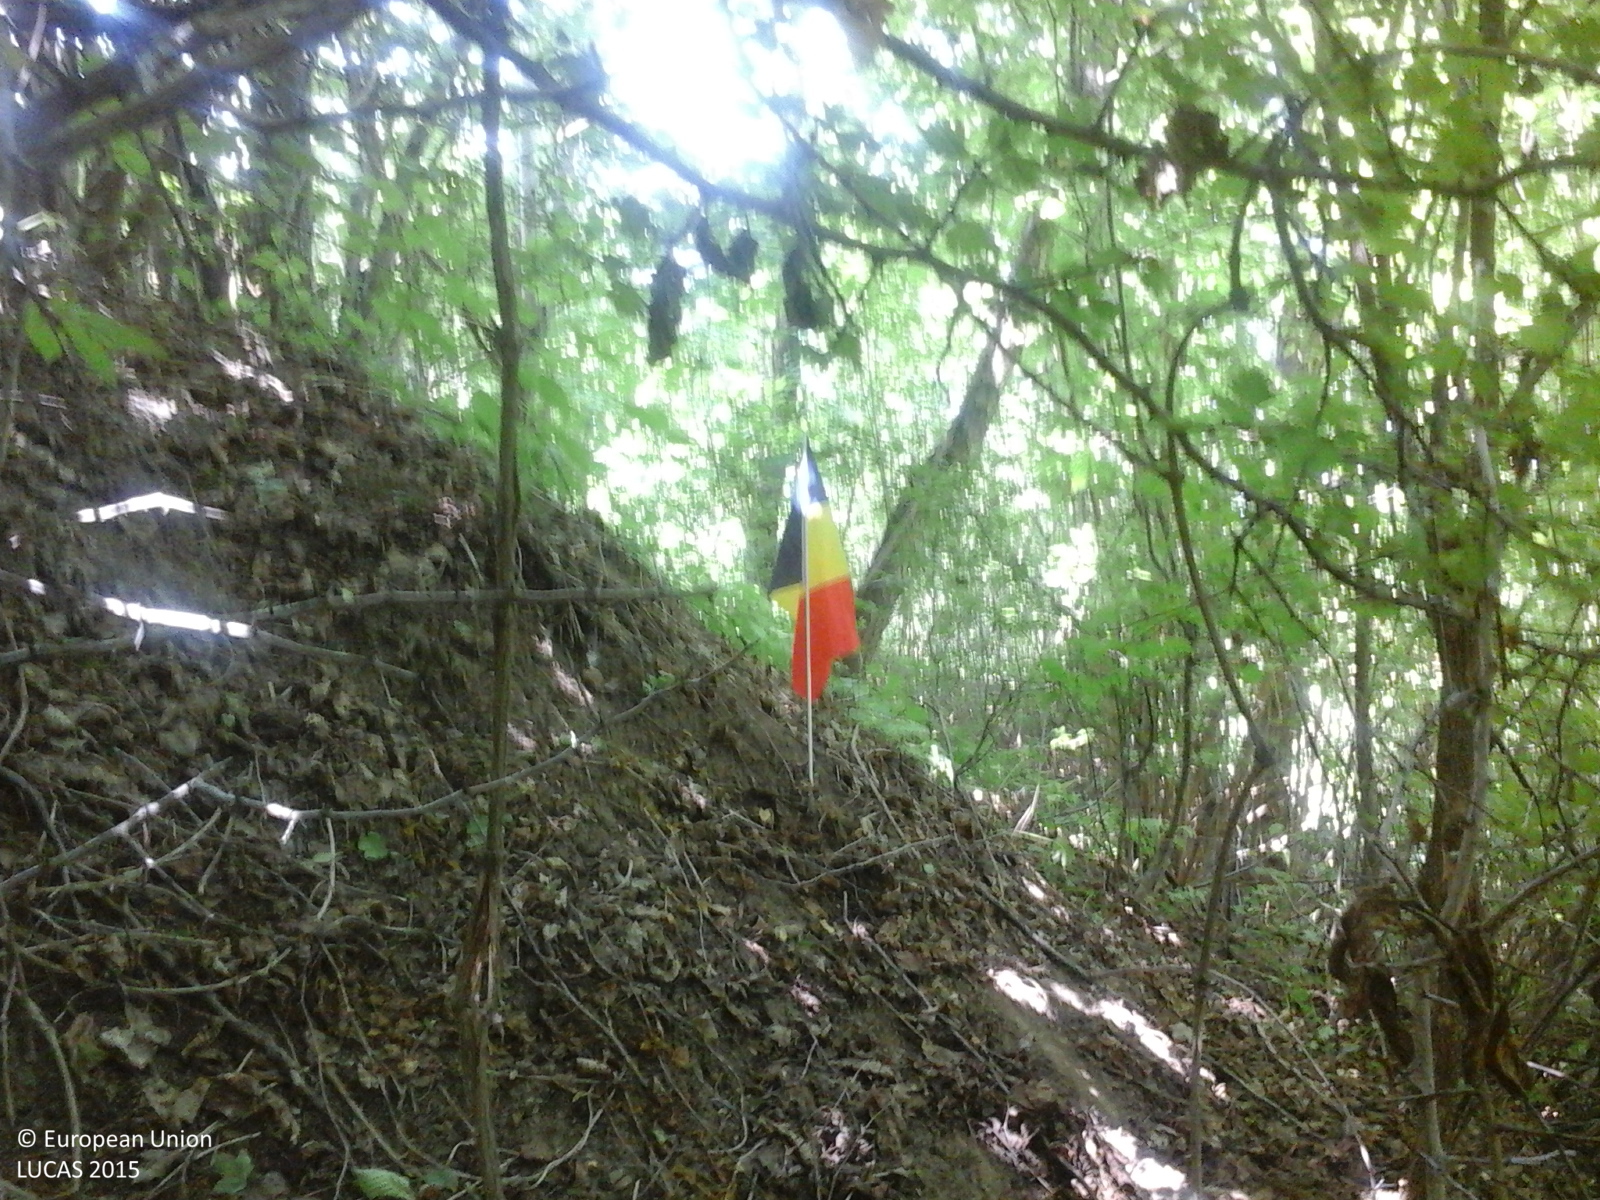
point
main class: Woodland
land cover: Broadleaved woodland
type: beech forest
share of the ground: > 75 %
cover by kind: broadleaved forest trees 100 %
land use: Forestry
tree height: > 5 m
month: June
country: RO
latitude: 46.5771
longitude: 26.5380
